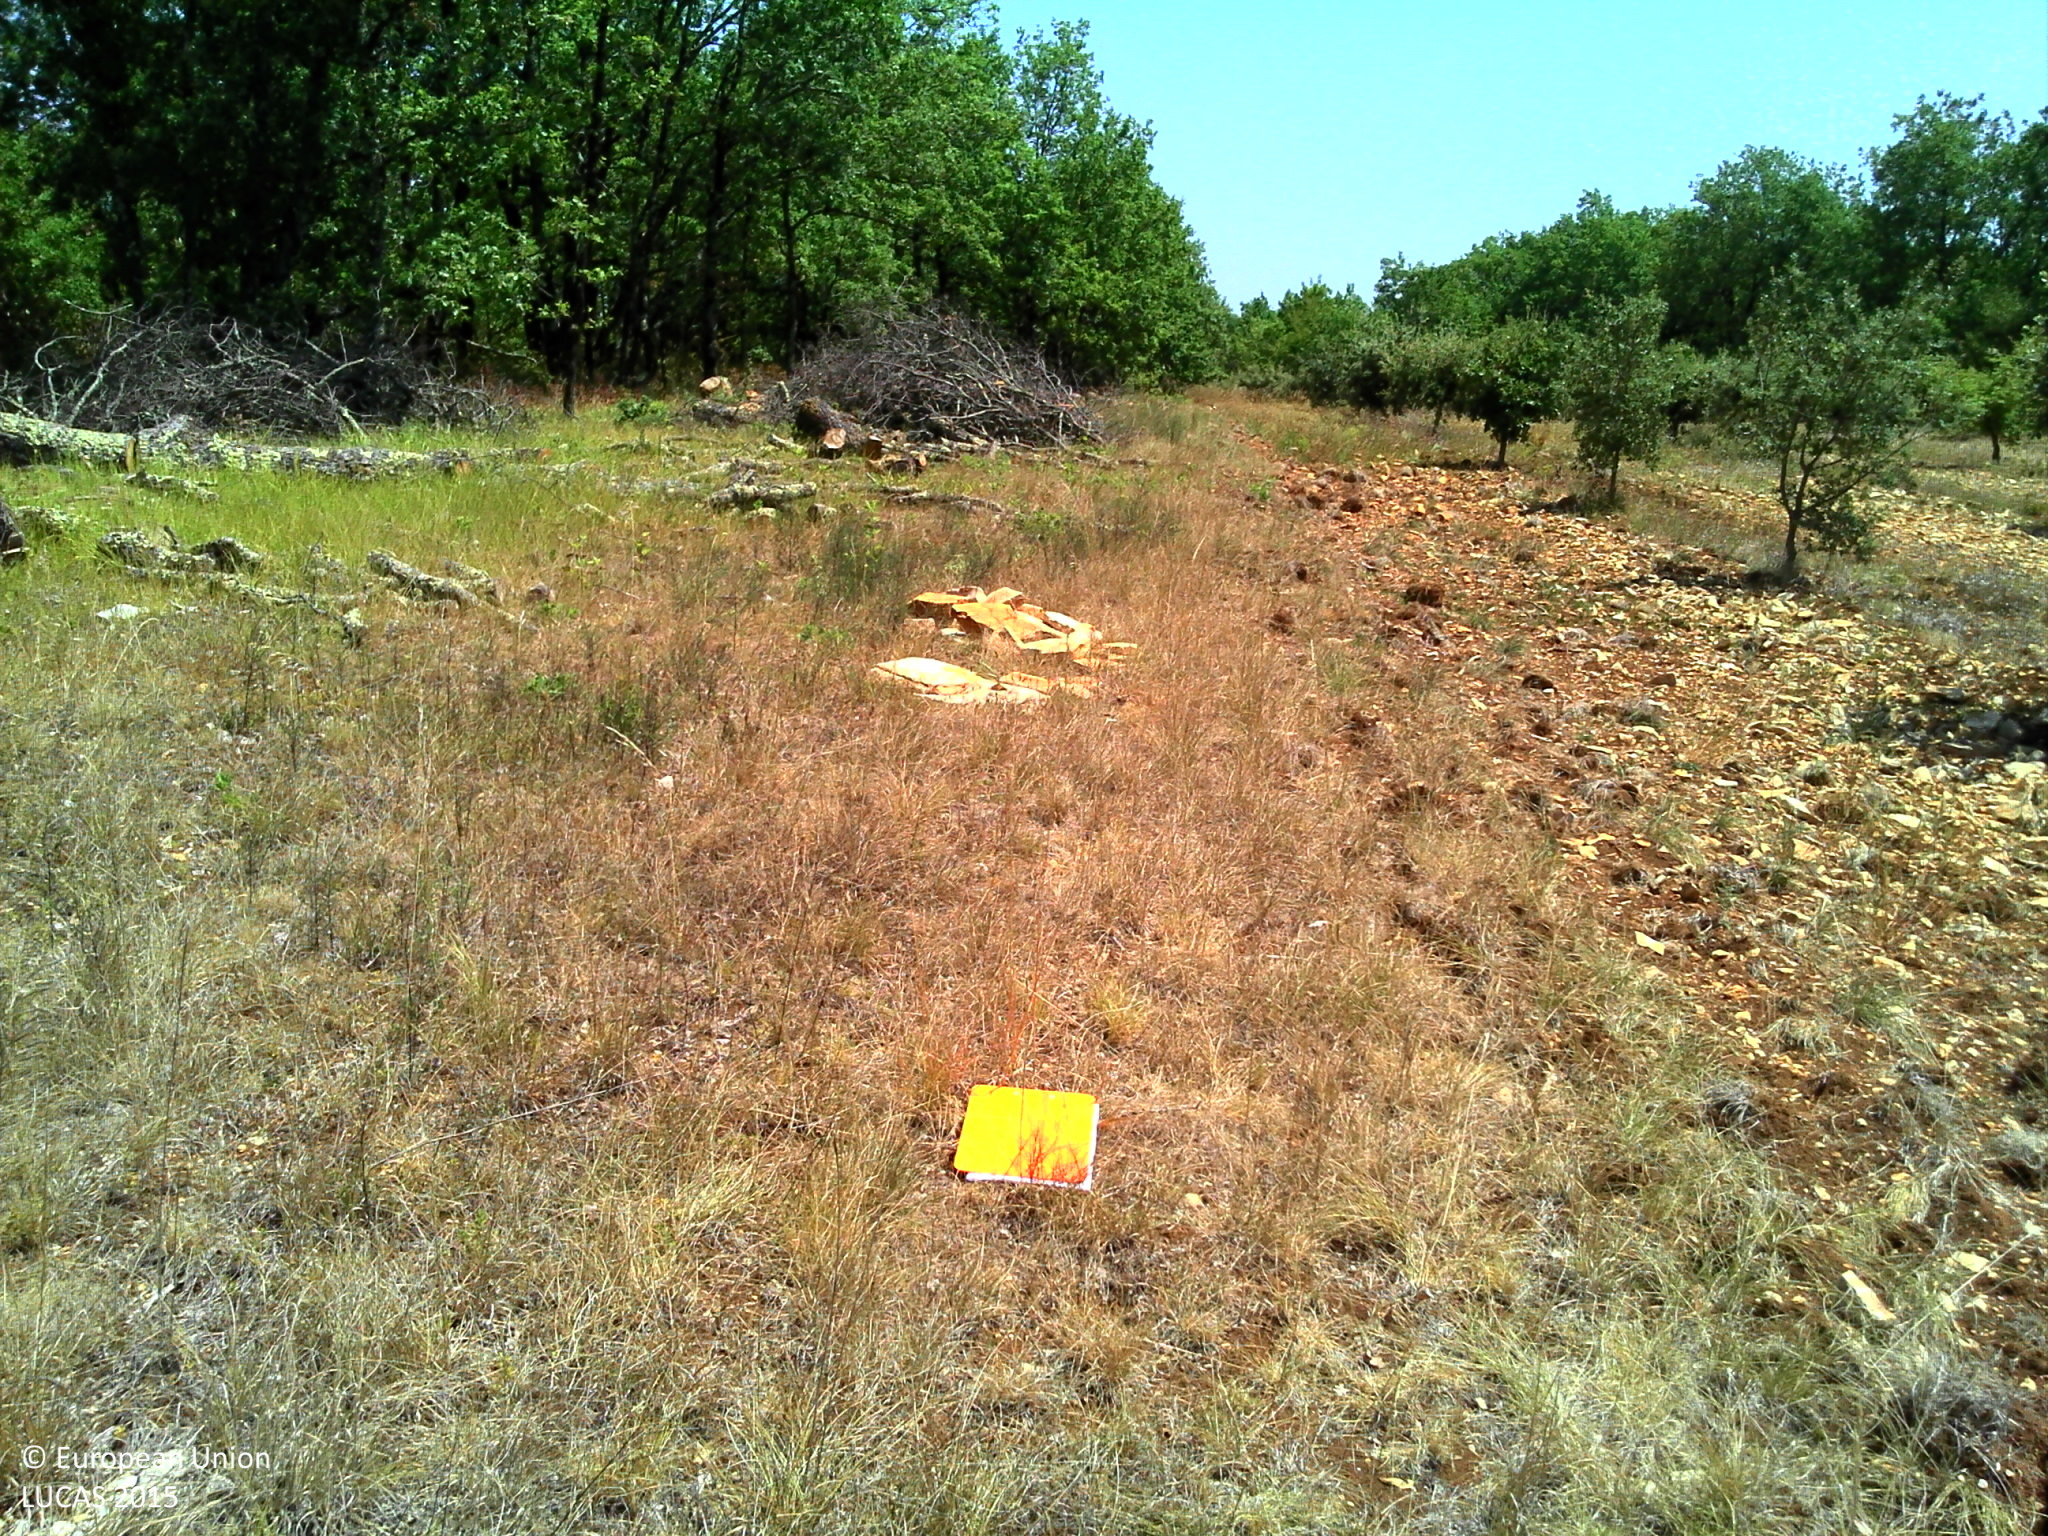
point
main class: Grassland
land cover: Spontaneously vegetated surfaces
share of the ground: > 75 %
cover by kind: herbaceous plants 100 %
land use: Agriculture (excluding fallow land and kitchen gardens)
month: August
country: FR
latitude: 44.7192
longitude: 1.1963
